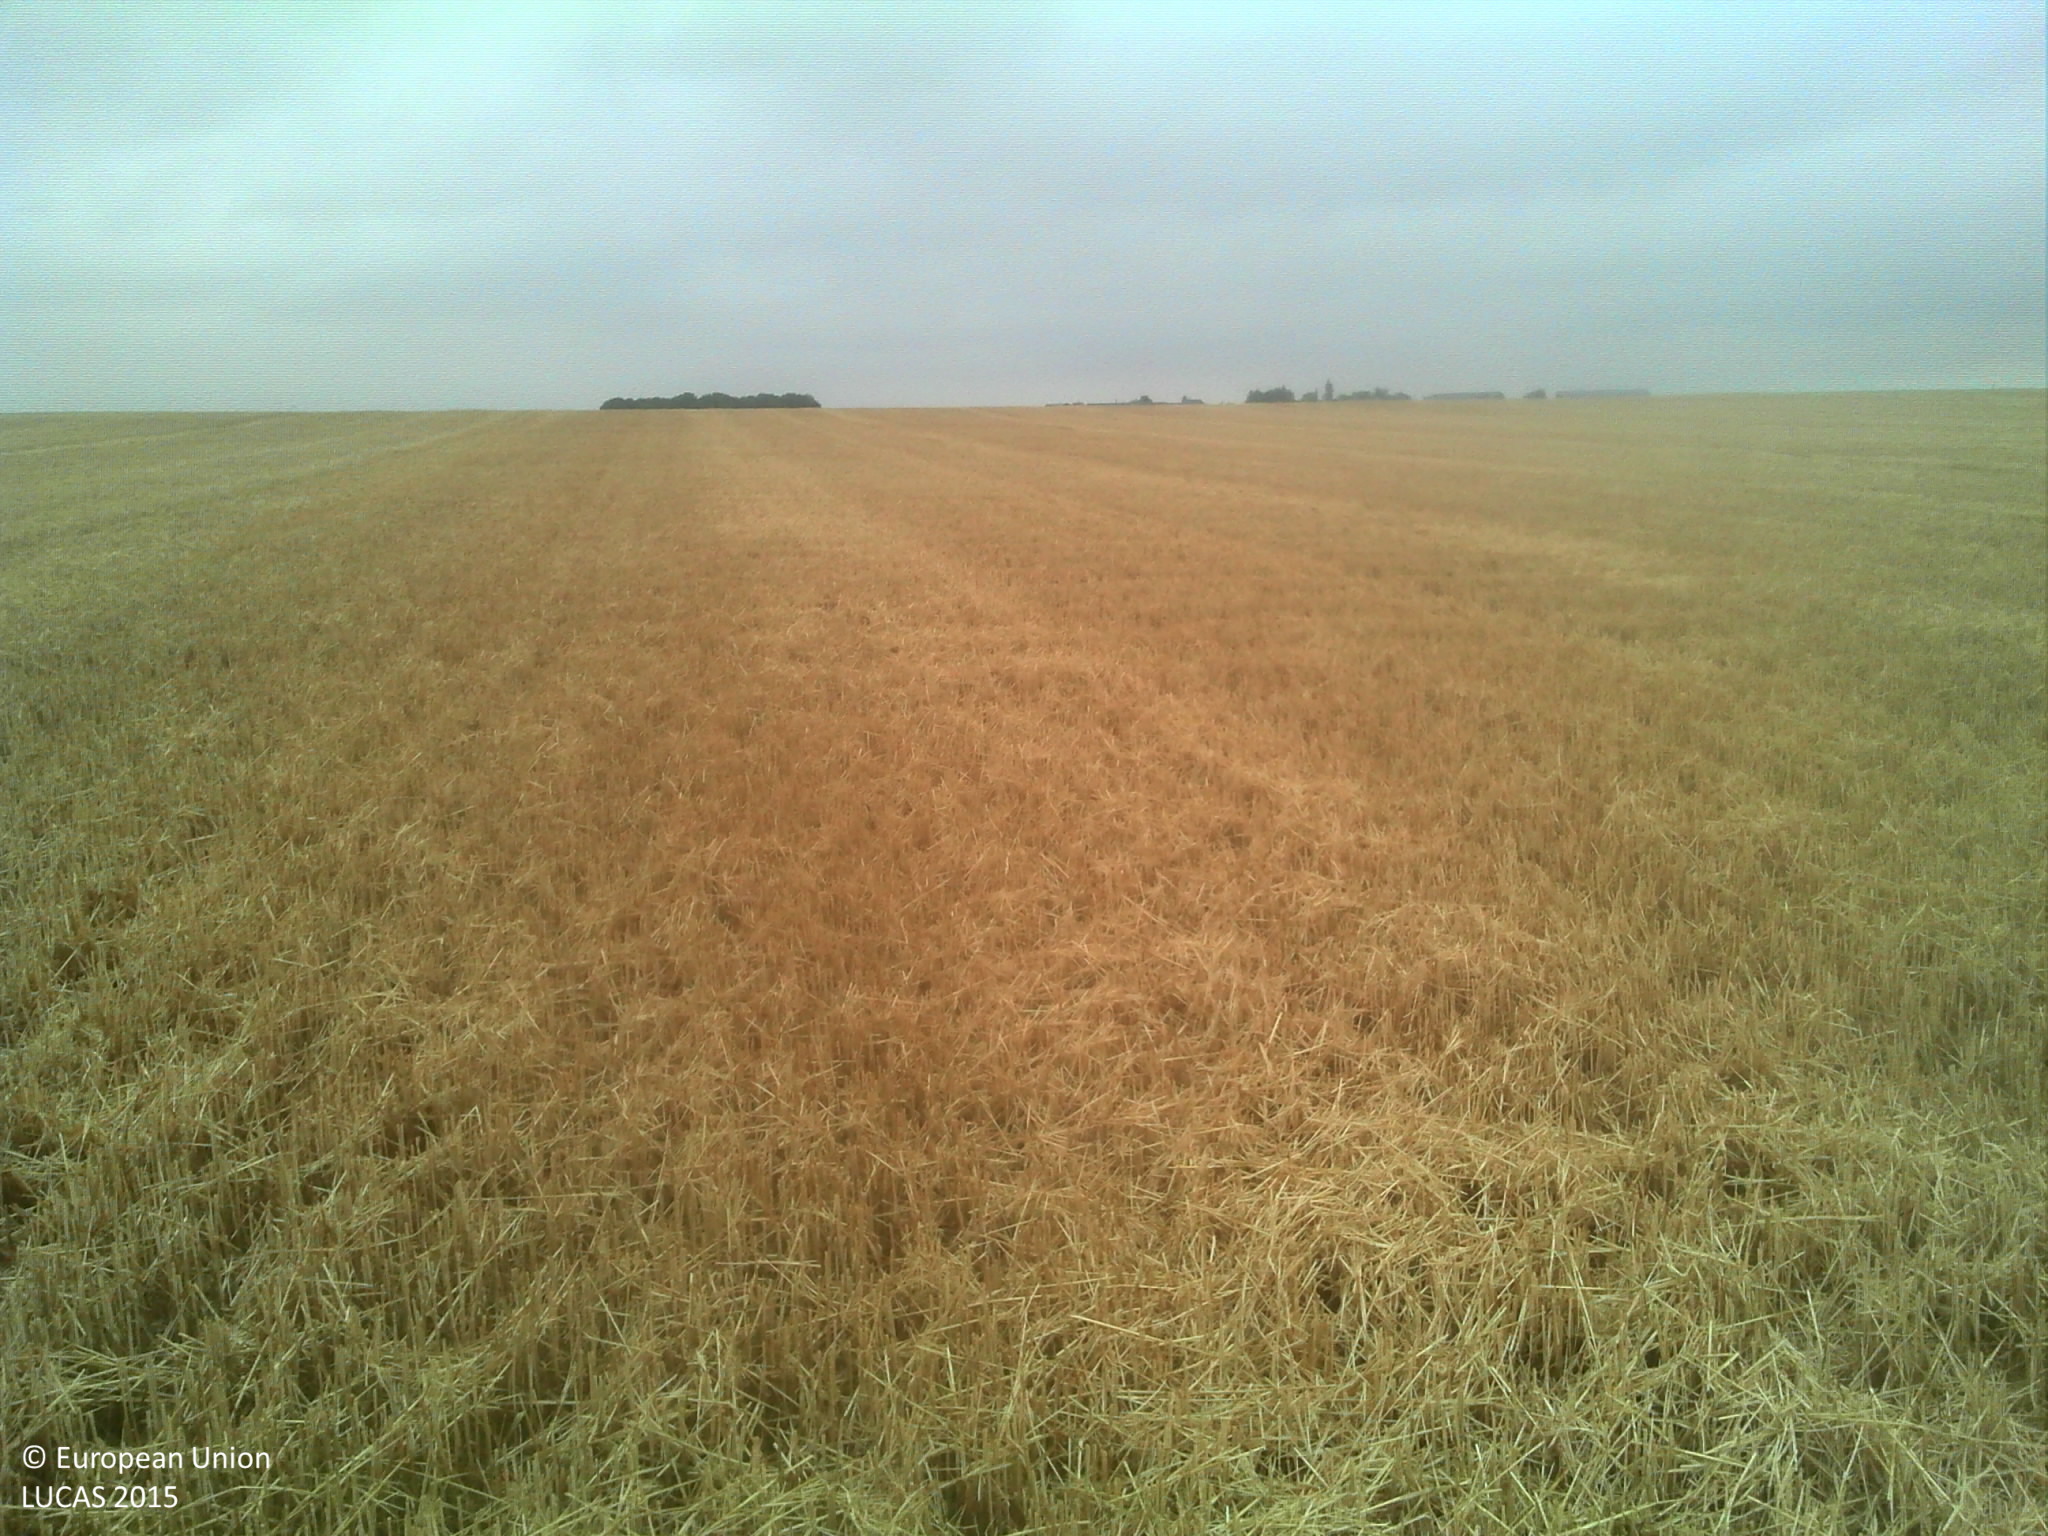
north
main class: Cropland
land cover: Durum wheat
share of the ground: > 75 %
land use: Agriculture (excluding fallow land and kitchen gardens)
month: July
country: FR
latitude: 47.6831
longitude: 1.3388
